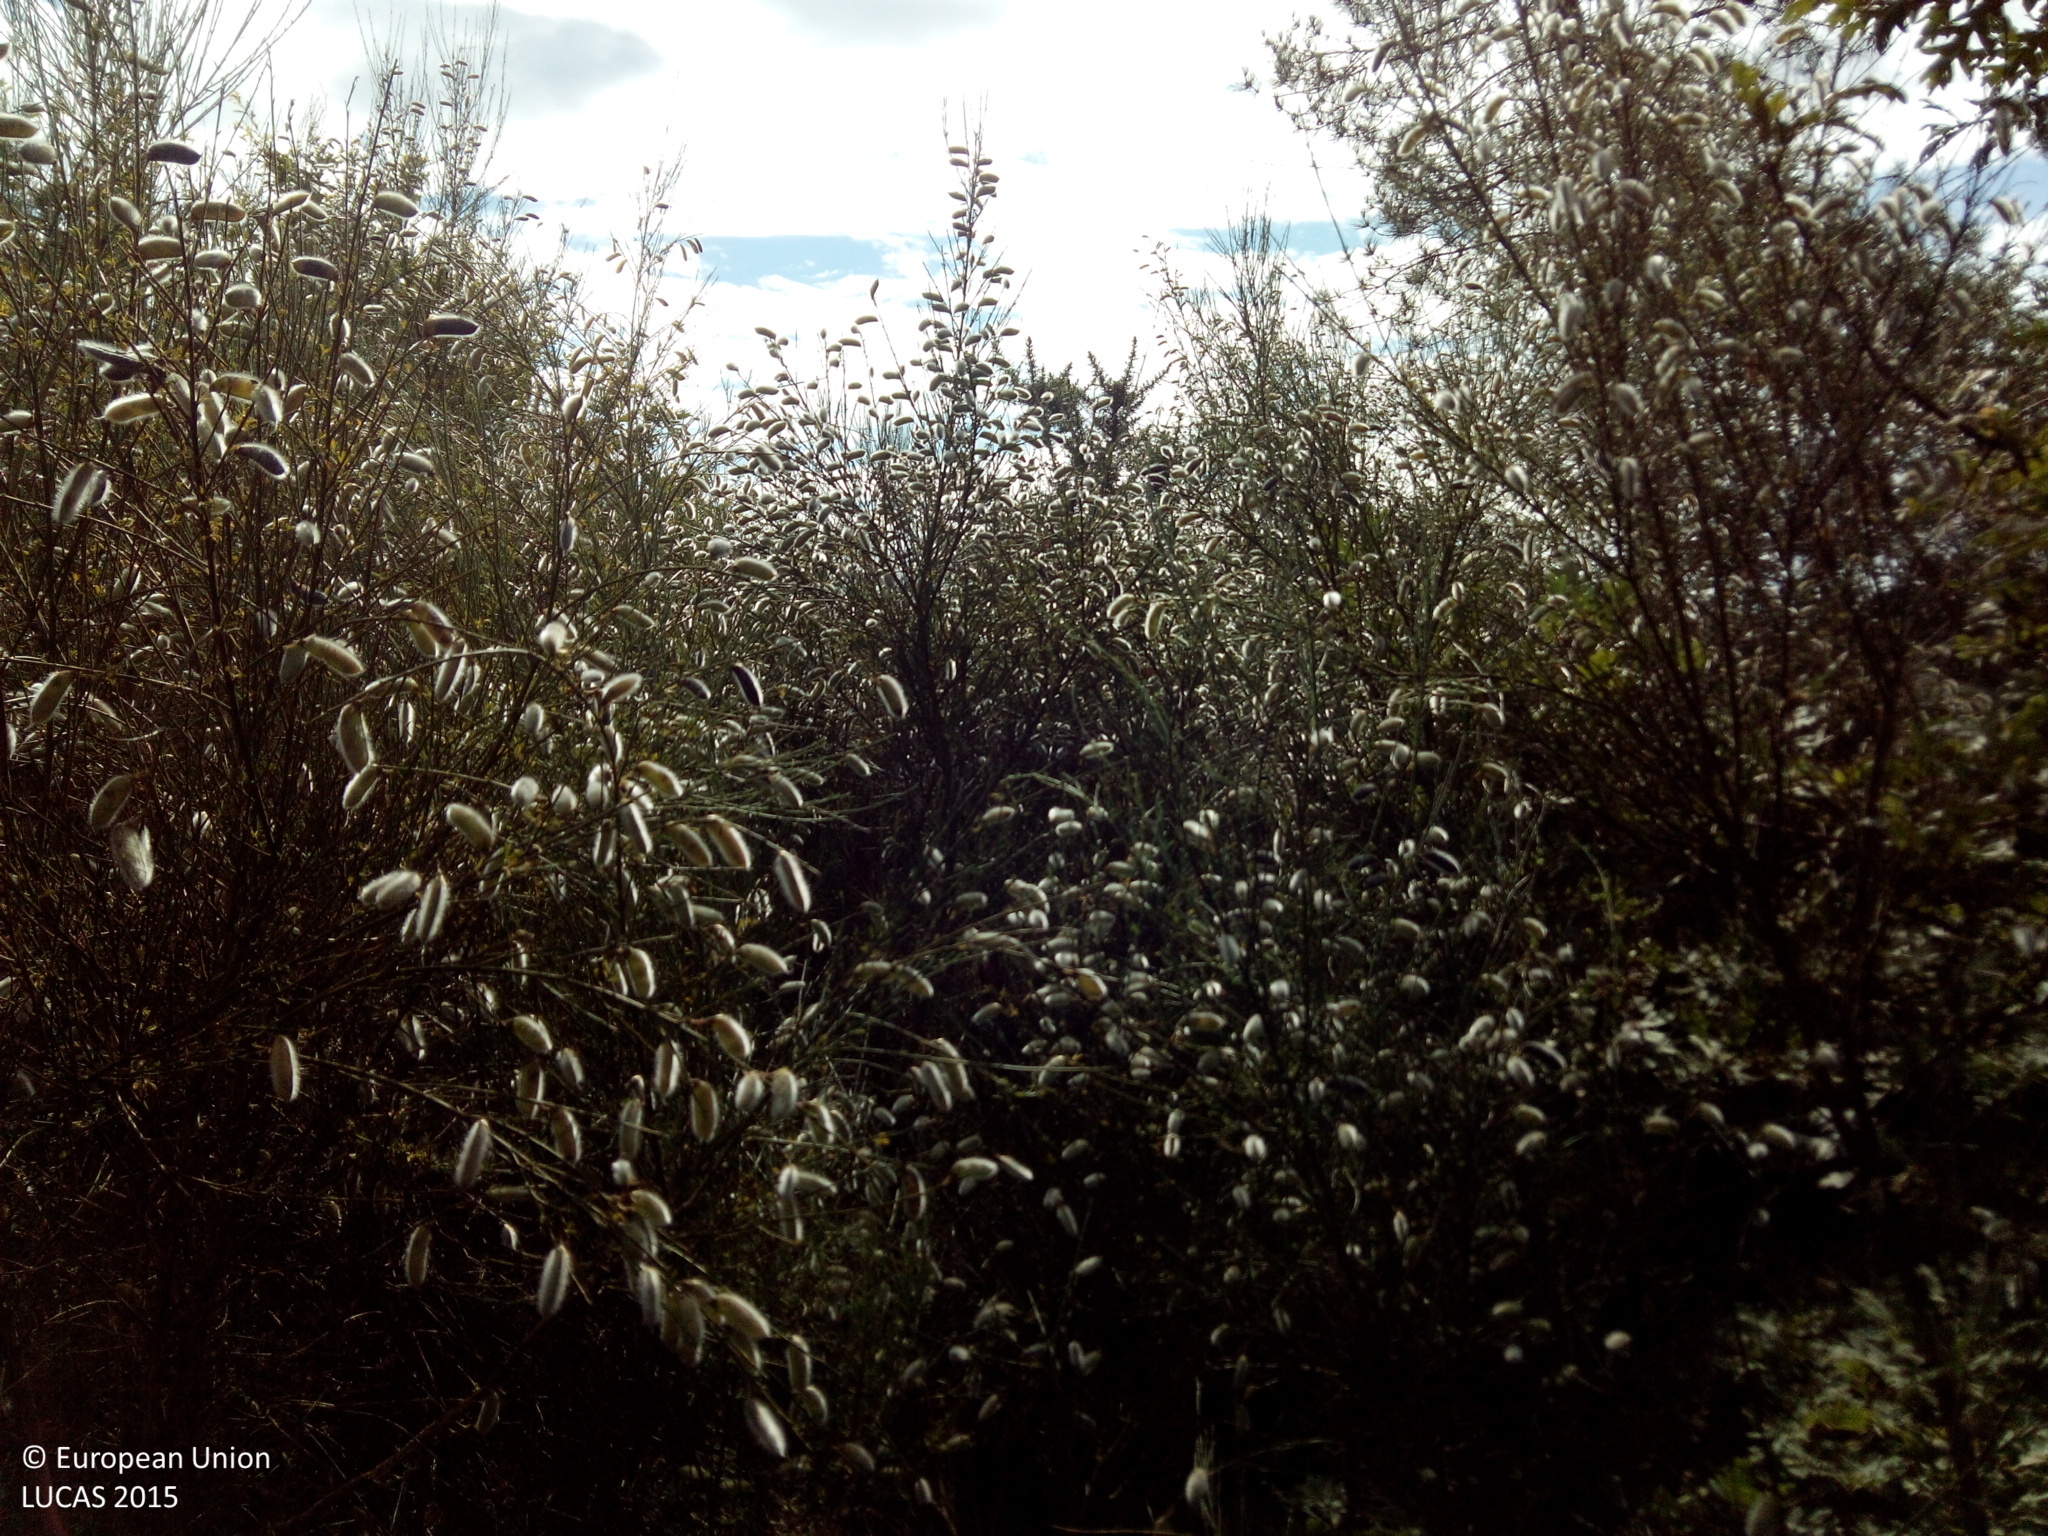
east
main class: Woodland
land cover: Other mixed woodland
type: acidophilous oak and oak-birch forest
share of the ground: > 75 %
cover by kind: shrubs 75 %, broadleaved forest trees 15 %, coniferous forest trees 10 %
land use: Abandoned areas
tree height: > 5 m
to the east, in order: Other mixed woodland; Broadleaved woodland; Ditches and canals; Paved roads, cycling and walking lanes; Shrubland with sparse tree cover; Dry stone walls; Grassland without tree/shrub cover; Shrubland without tree cover; Tracks; Dry stone walls; Shrubland without tree cover
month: July
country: ES
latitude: 42.3615
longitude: -8.2653
